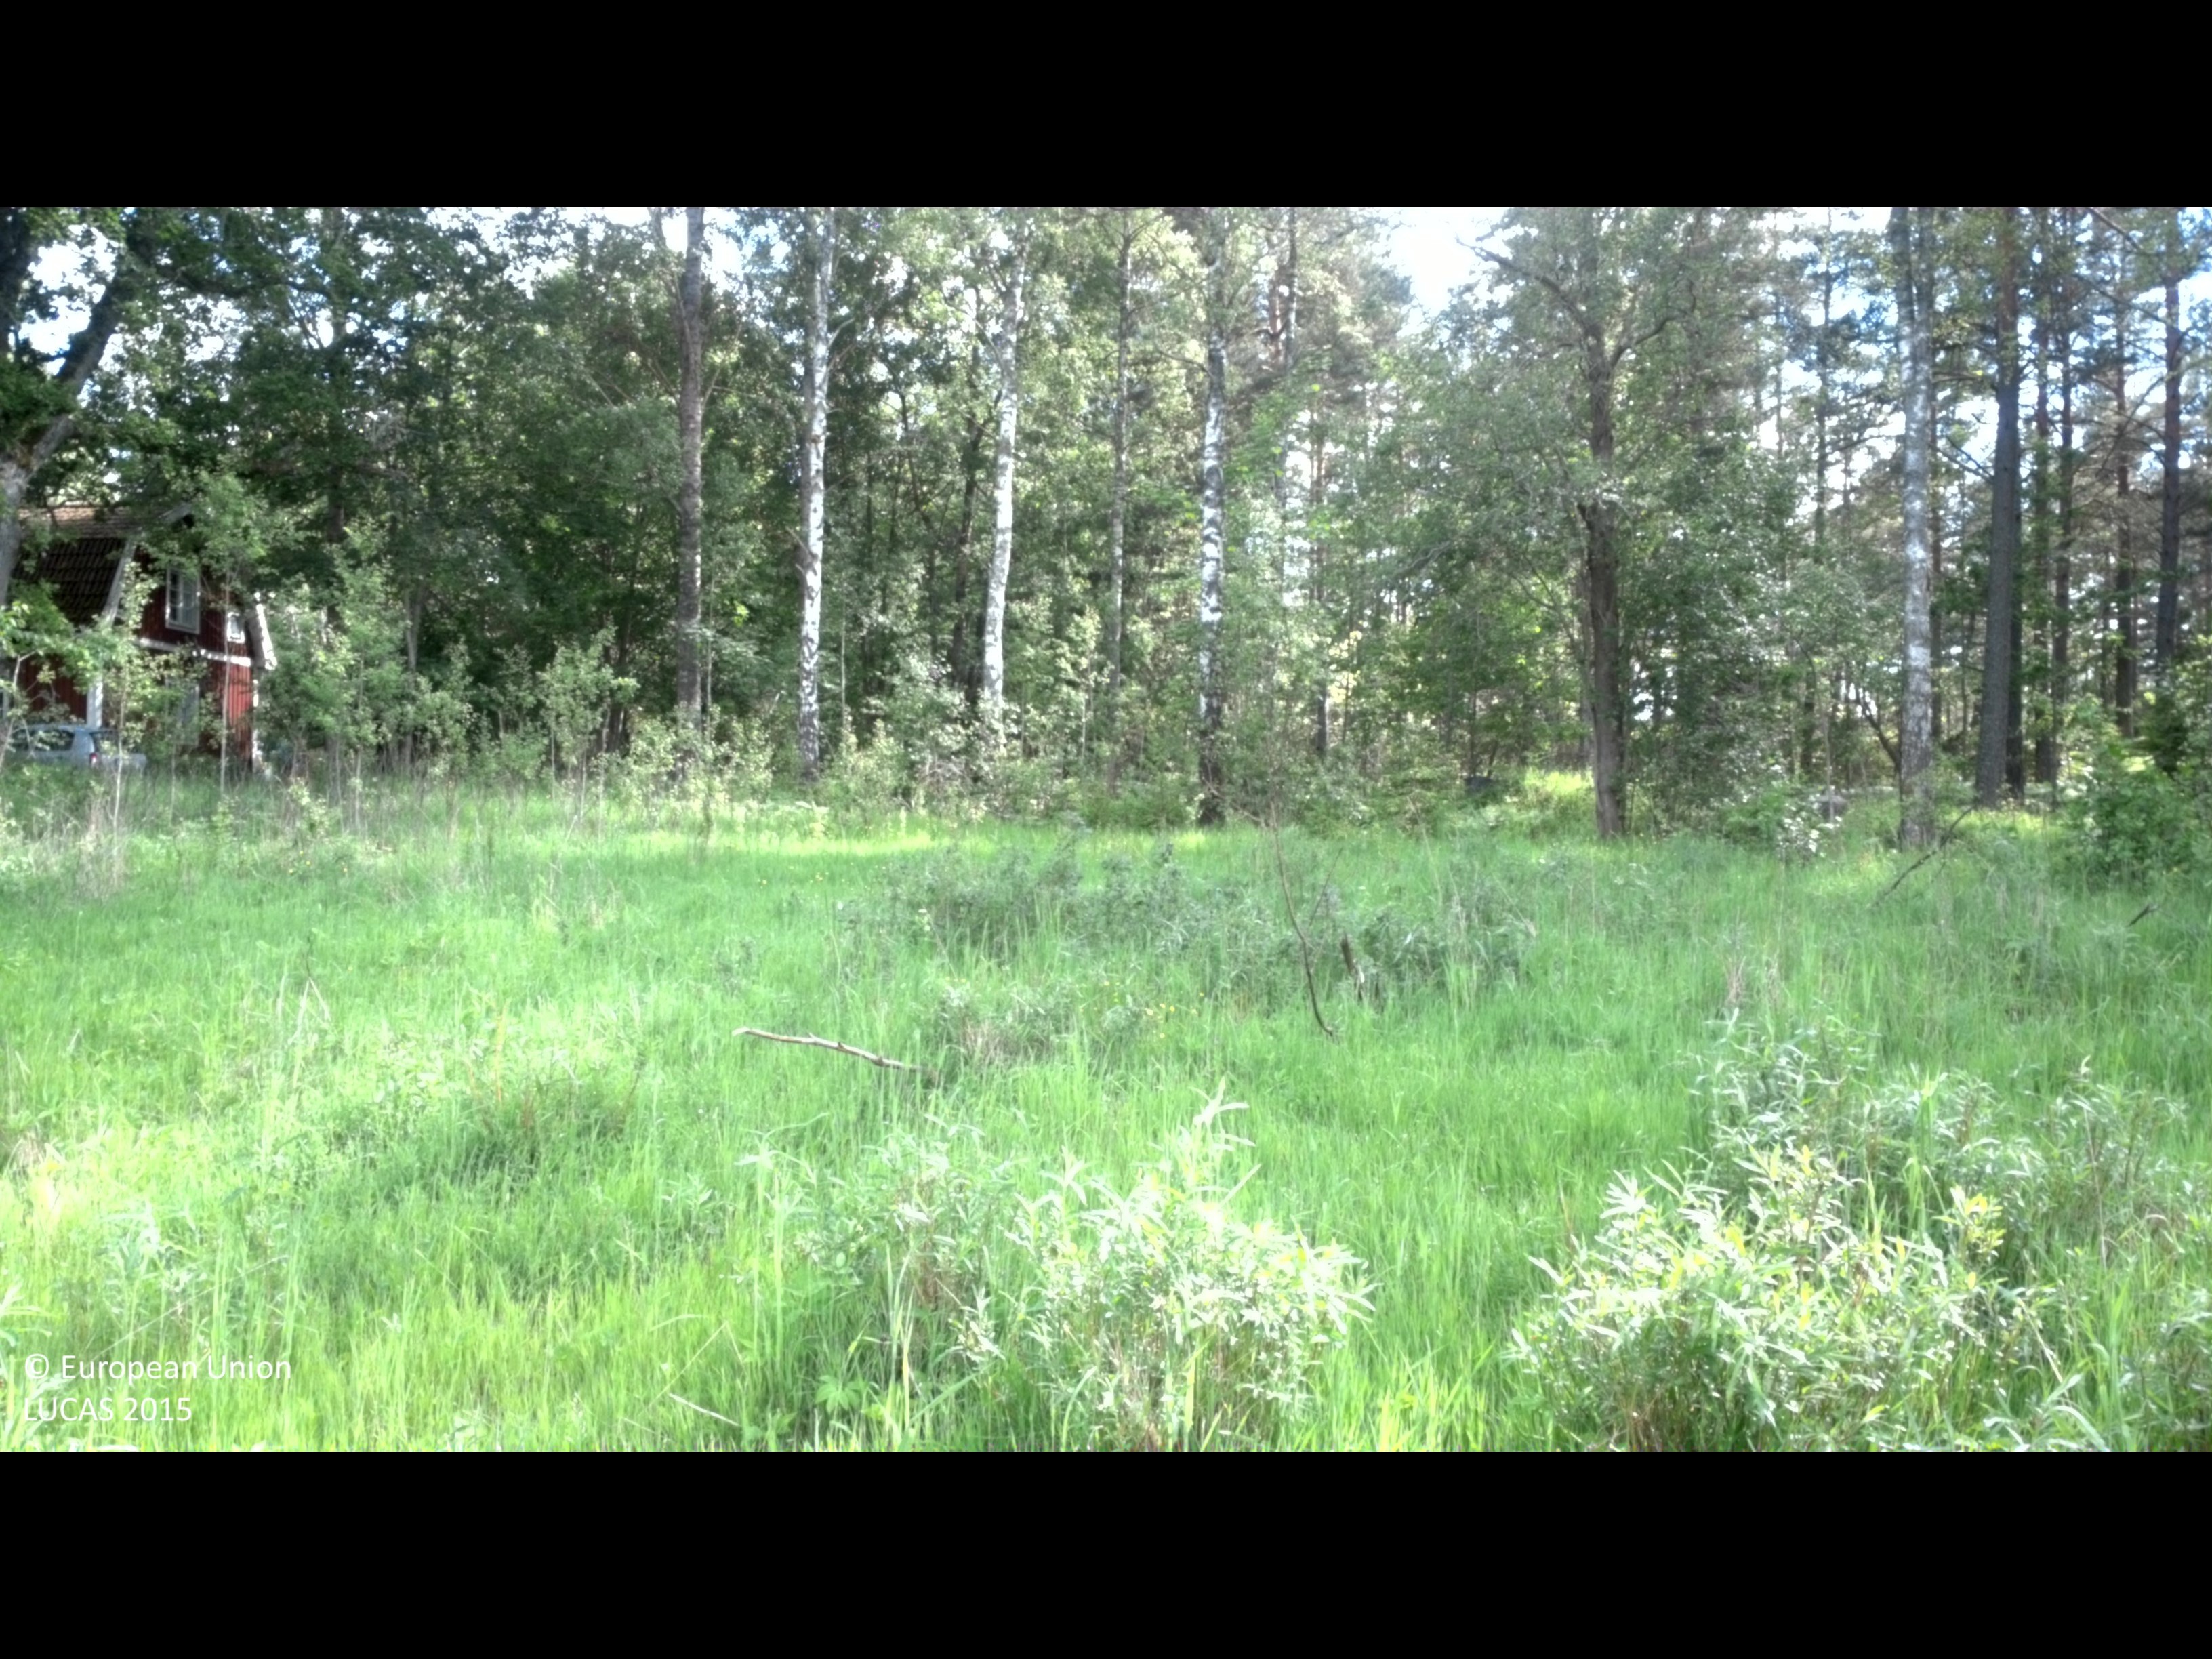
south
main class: Cropland
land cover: Permanent industrial crops
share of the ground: 25 - 50 %
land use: Agriculture (excluding fallow land and kitchen gardens)
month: June
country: SE
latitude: 57.7520
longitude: 16.5687
